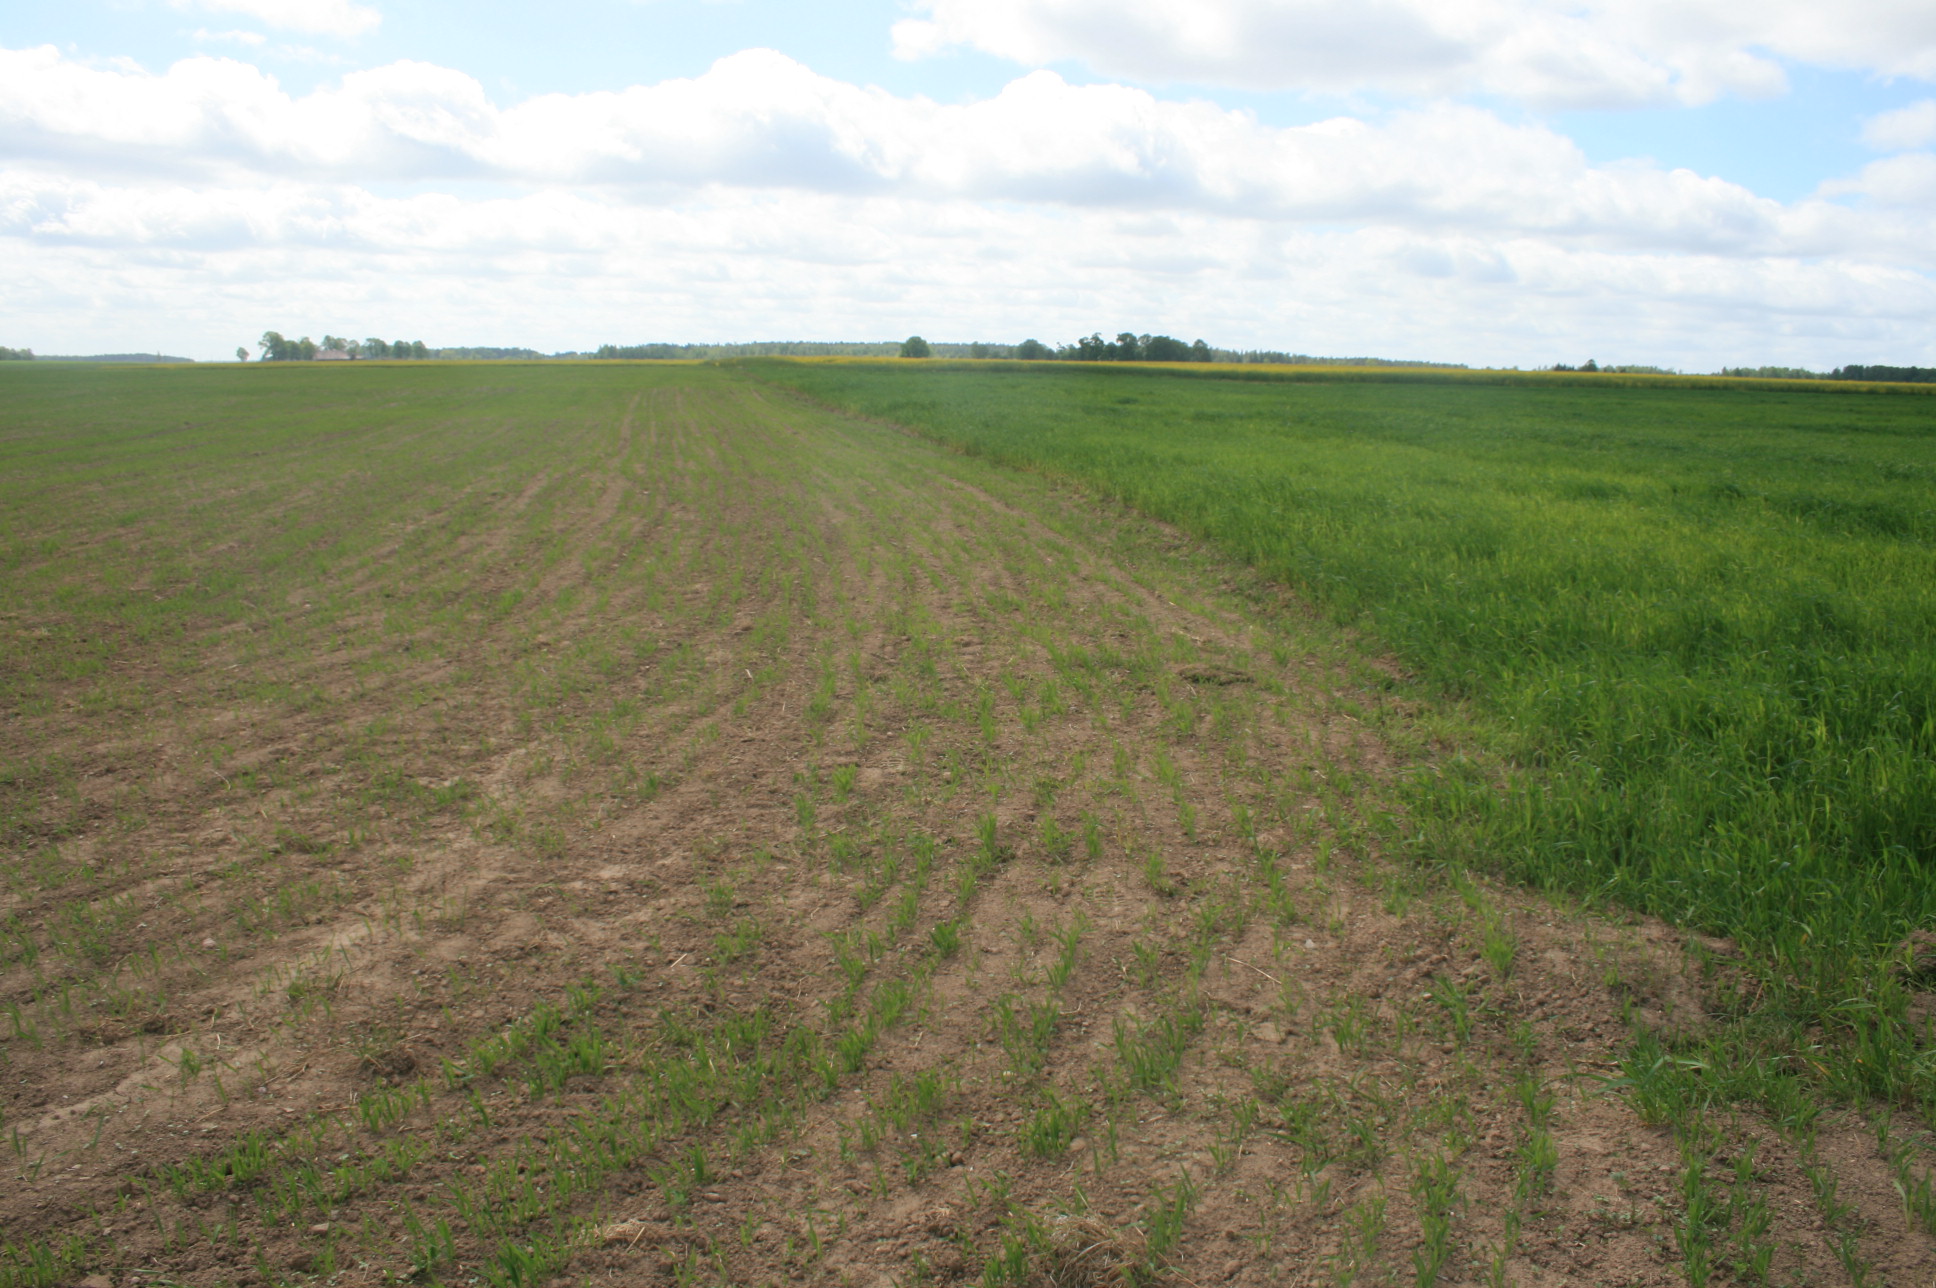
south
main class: Cropland
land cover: Other leguminous and mixtures for fodder
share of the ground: < 10 %
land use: Agriculture (excluding fallow land and kitchen gardens)
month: June
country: LT
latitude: 56.1893
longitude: 22.3508
